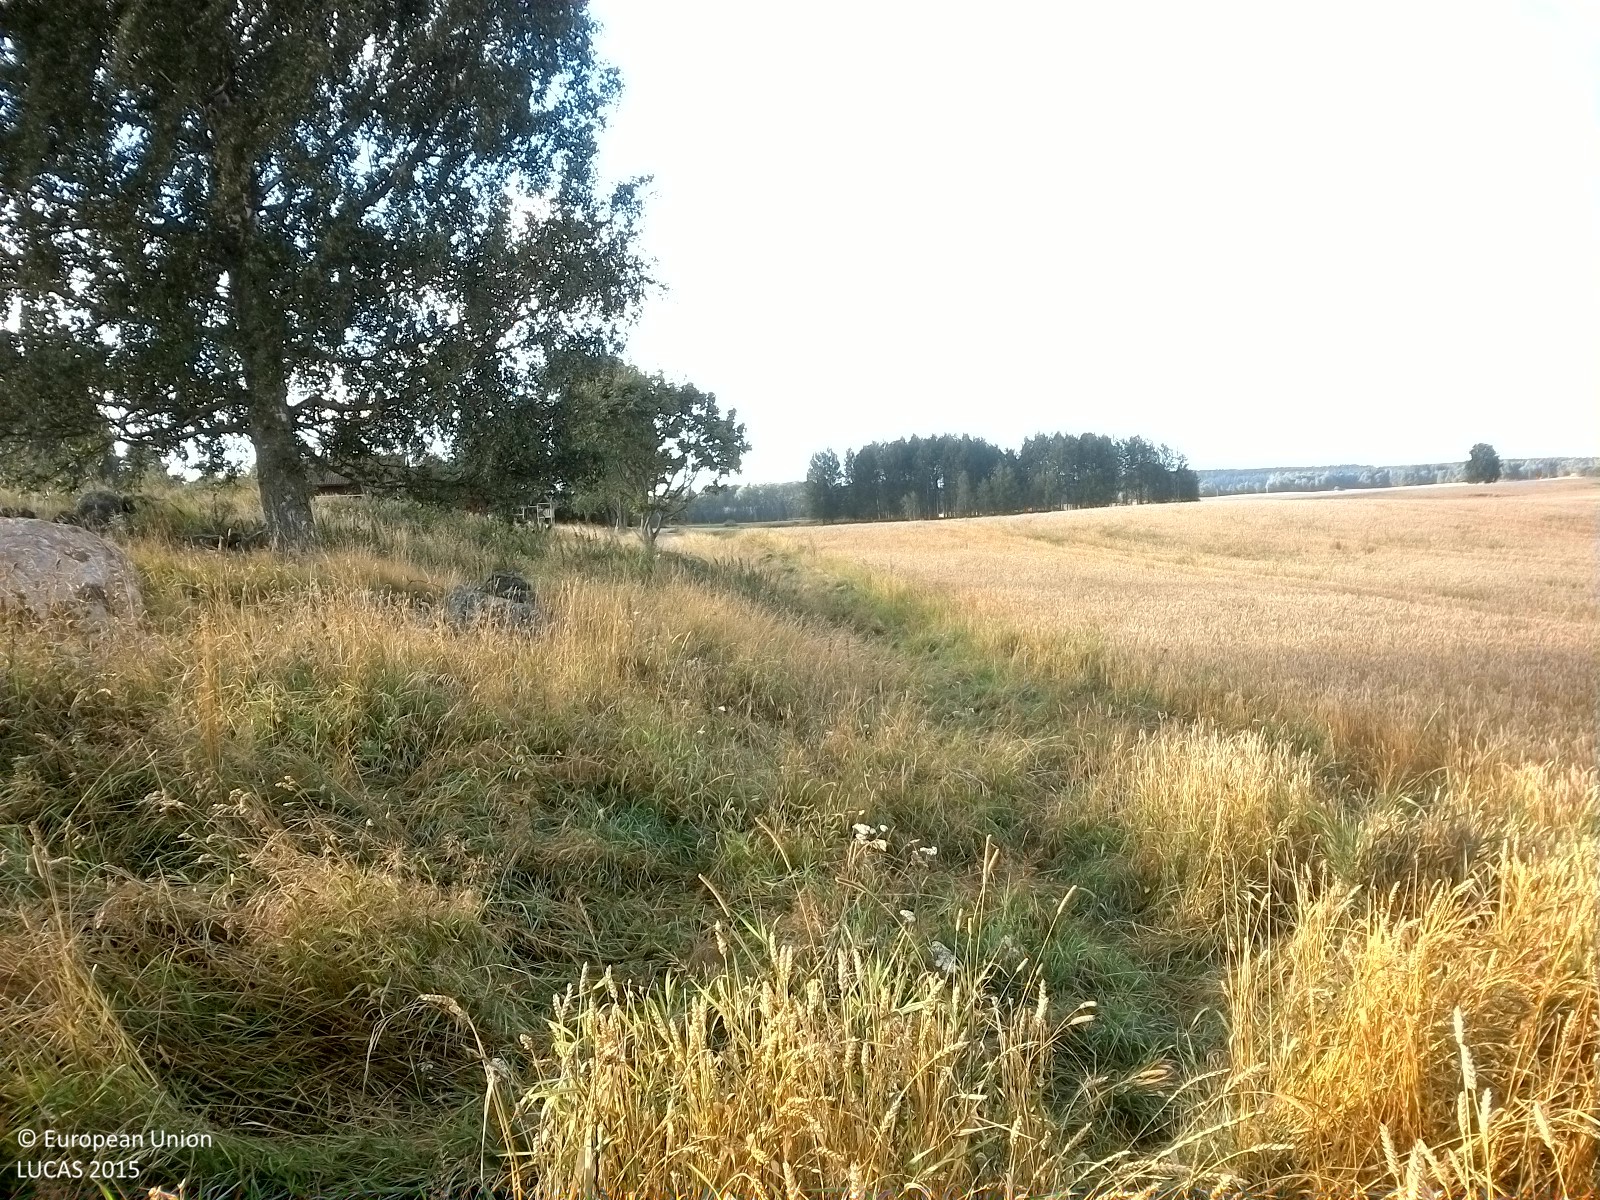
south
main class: Cropland
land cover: Common wheat
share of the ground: > 75 %
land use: Agriculture (excluding fallow land and kitchen gardens)
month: August
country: SE
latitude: 58.9201
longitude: 15.4635
